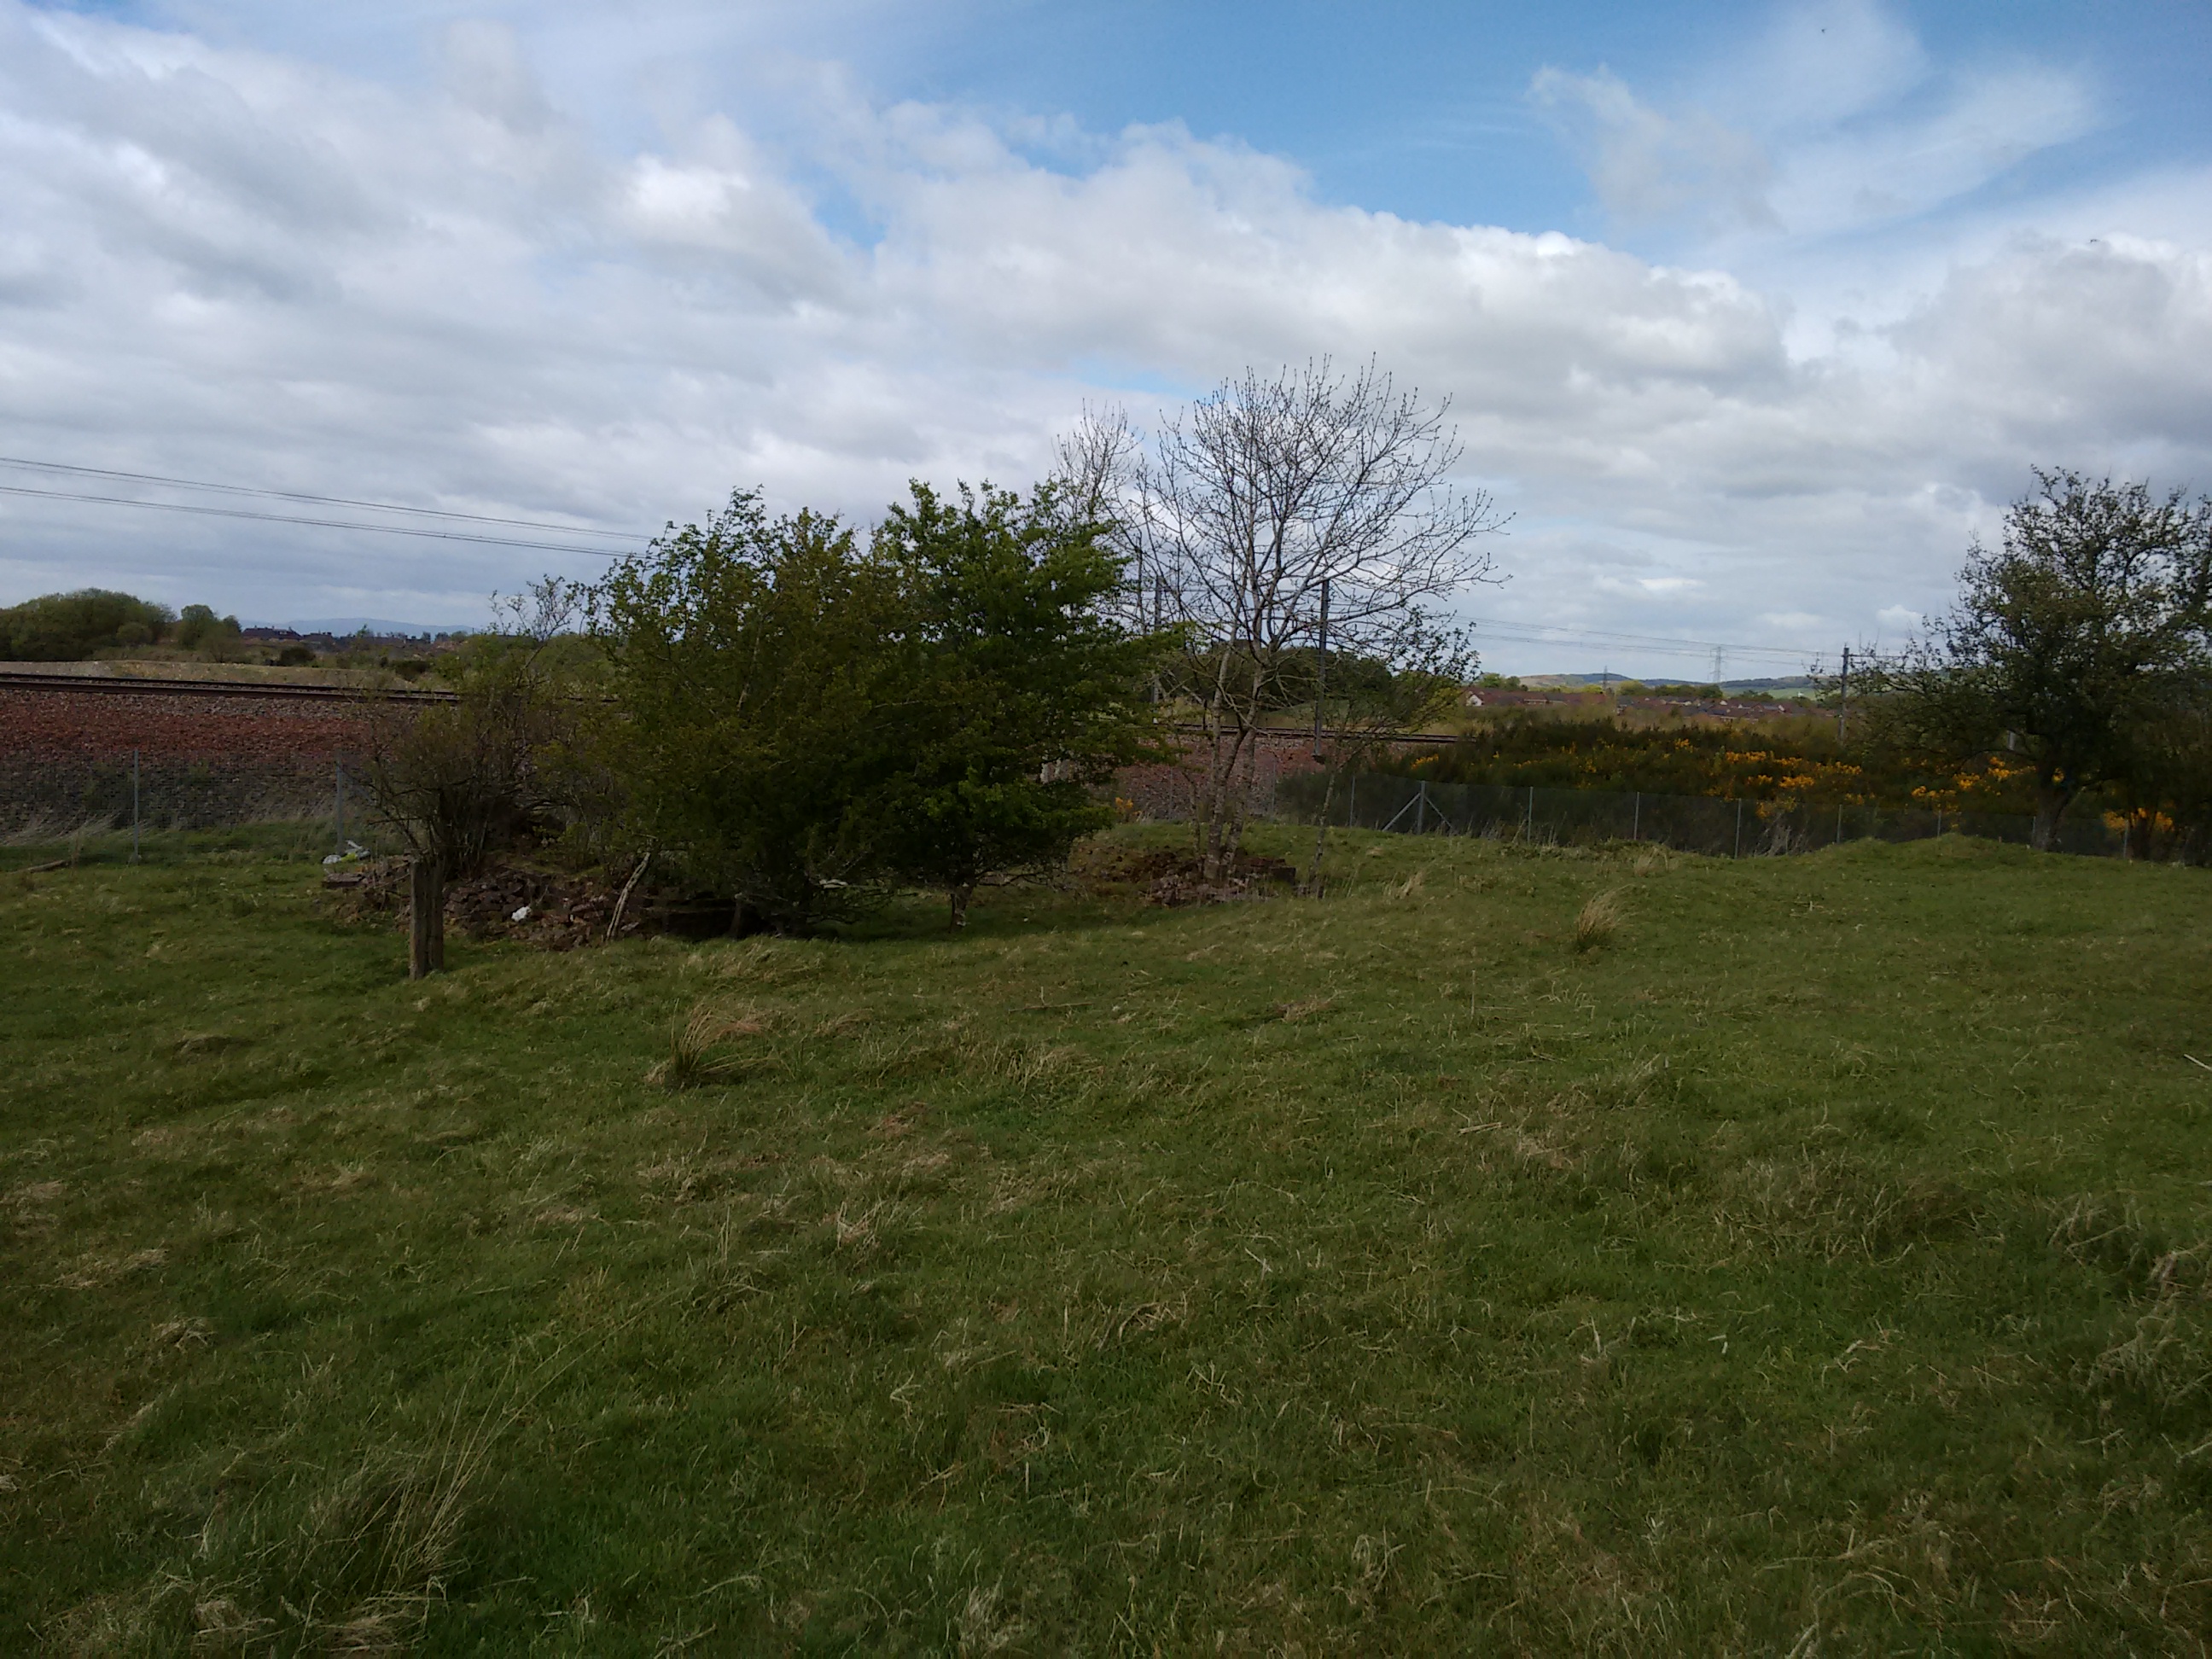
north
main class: Grassland
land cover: Grassland without tree/shrub cover
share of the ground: > 75 %
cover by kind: herbaceous plants 95 %, shrubs 5 %
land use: Agriculture (excluding fallow land and kitchen gardens)
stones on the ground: < 10 %
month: May
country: GB
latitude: 55.8880
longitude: -3.6875
